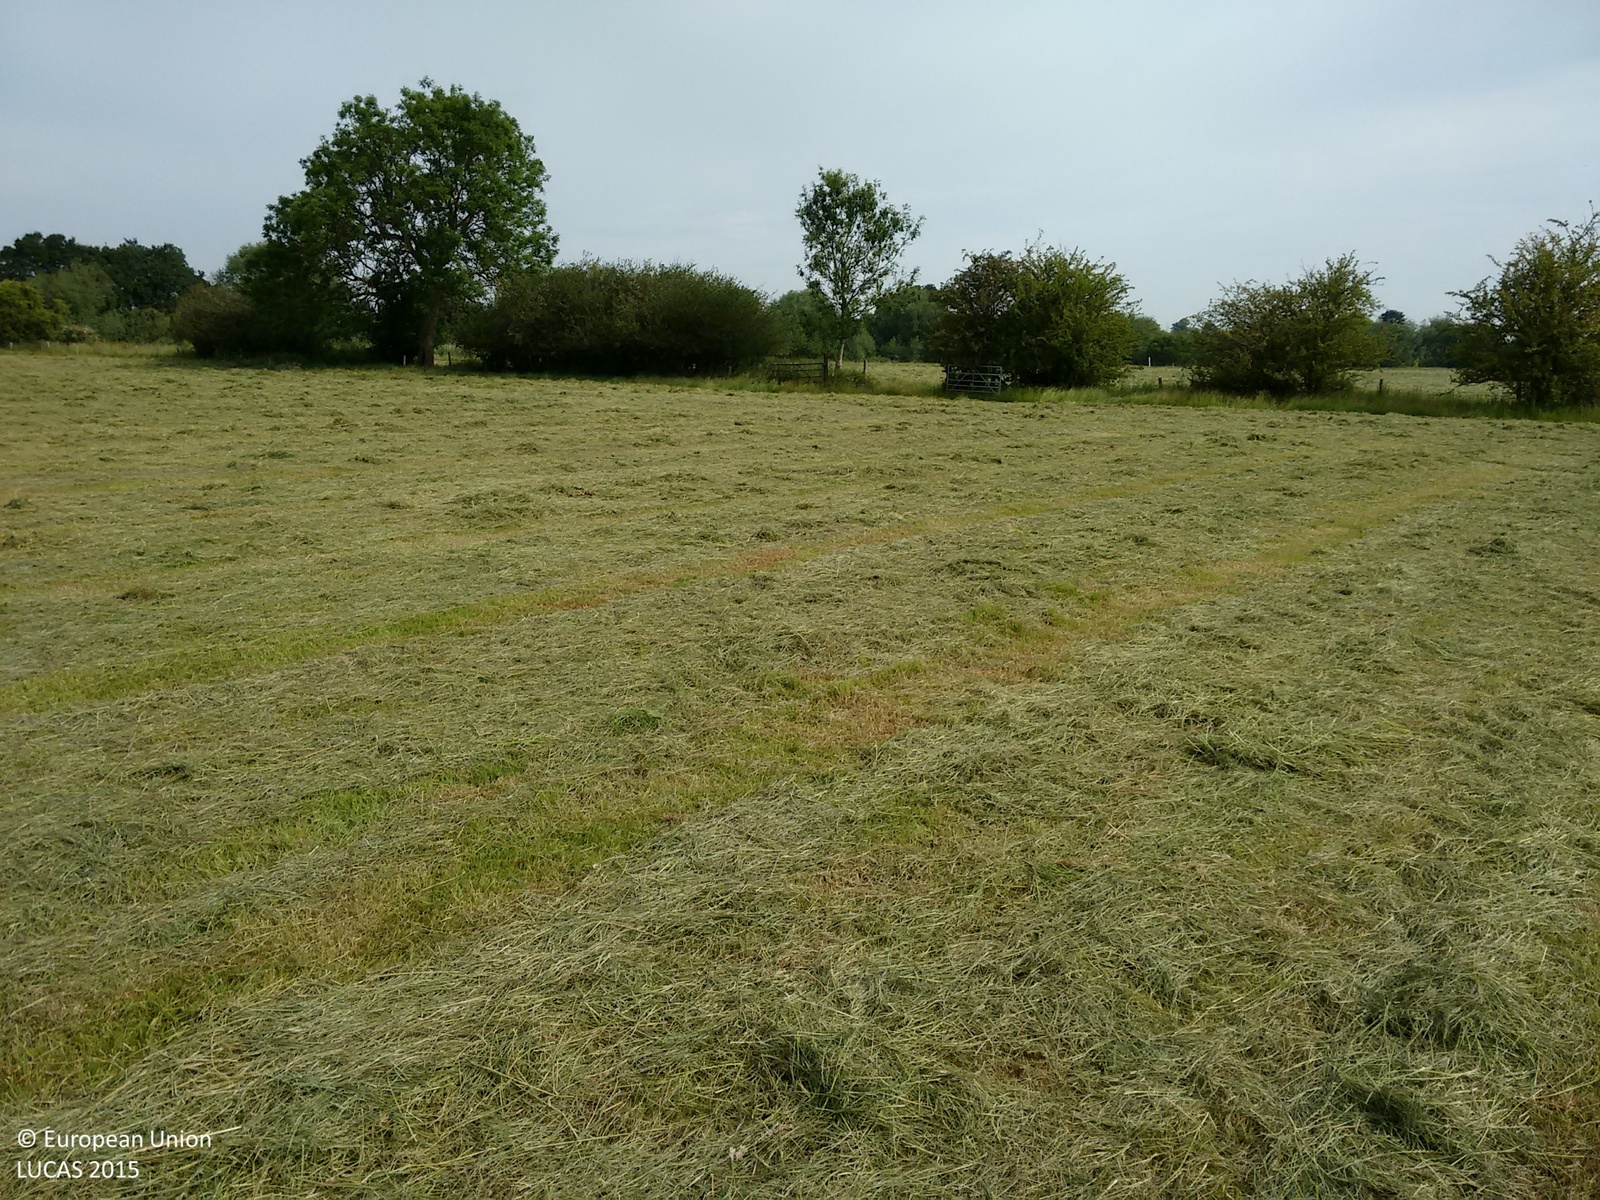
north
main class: Grassland
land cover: Grassland without tree/shrub cover
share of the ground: > 75 %
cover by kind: herbaceous plants 100 %
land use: Agriculture (excluding fallow land and kitchen gardens)
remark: Harvested field
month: June
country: GB
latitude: 51.5609
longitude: -1.1389
